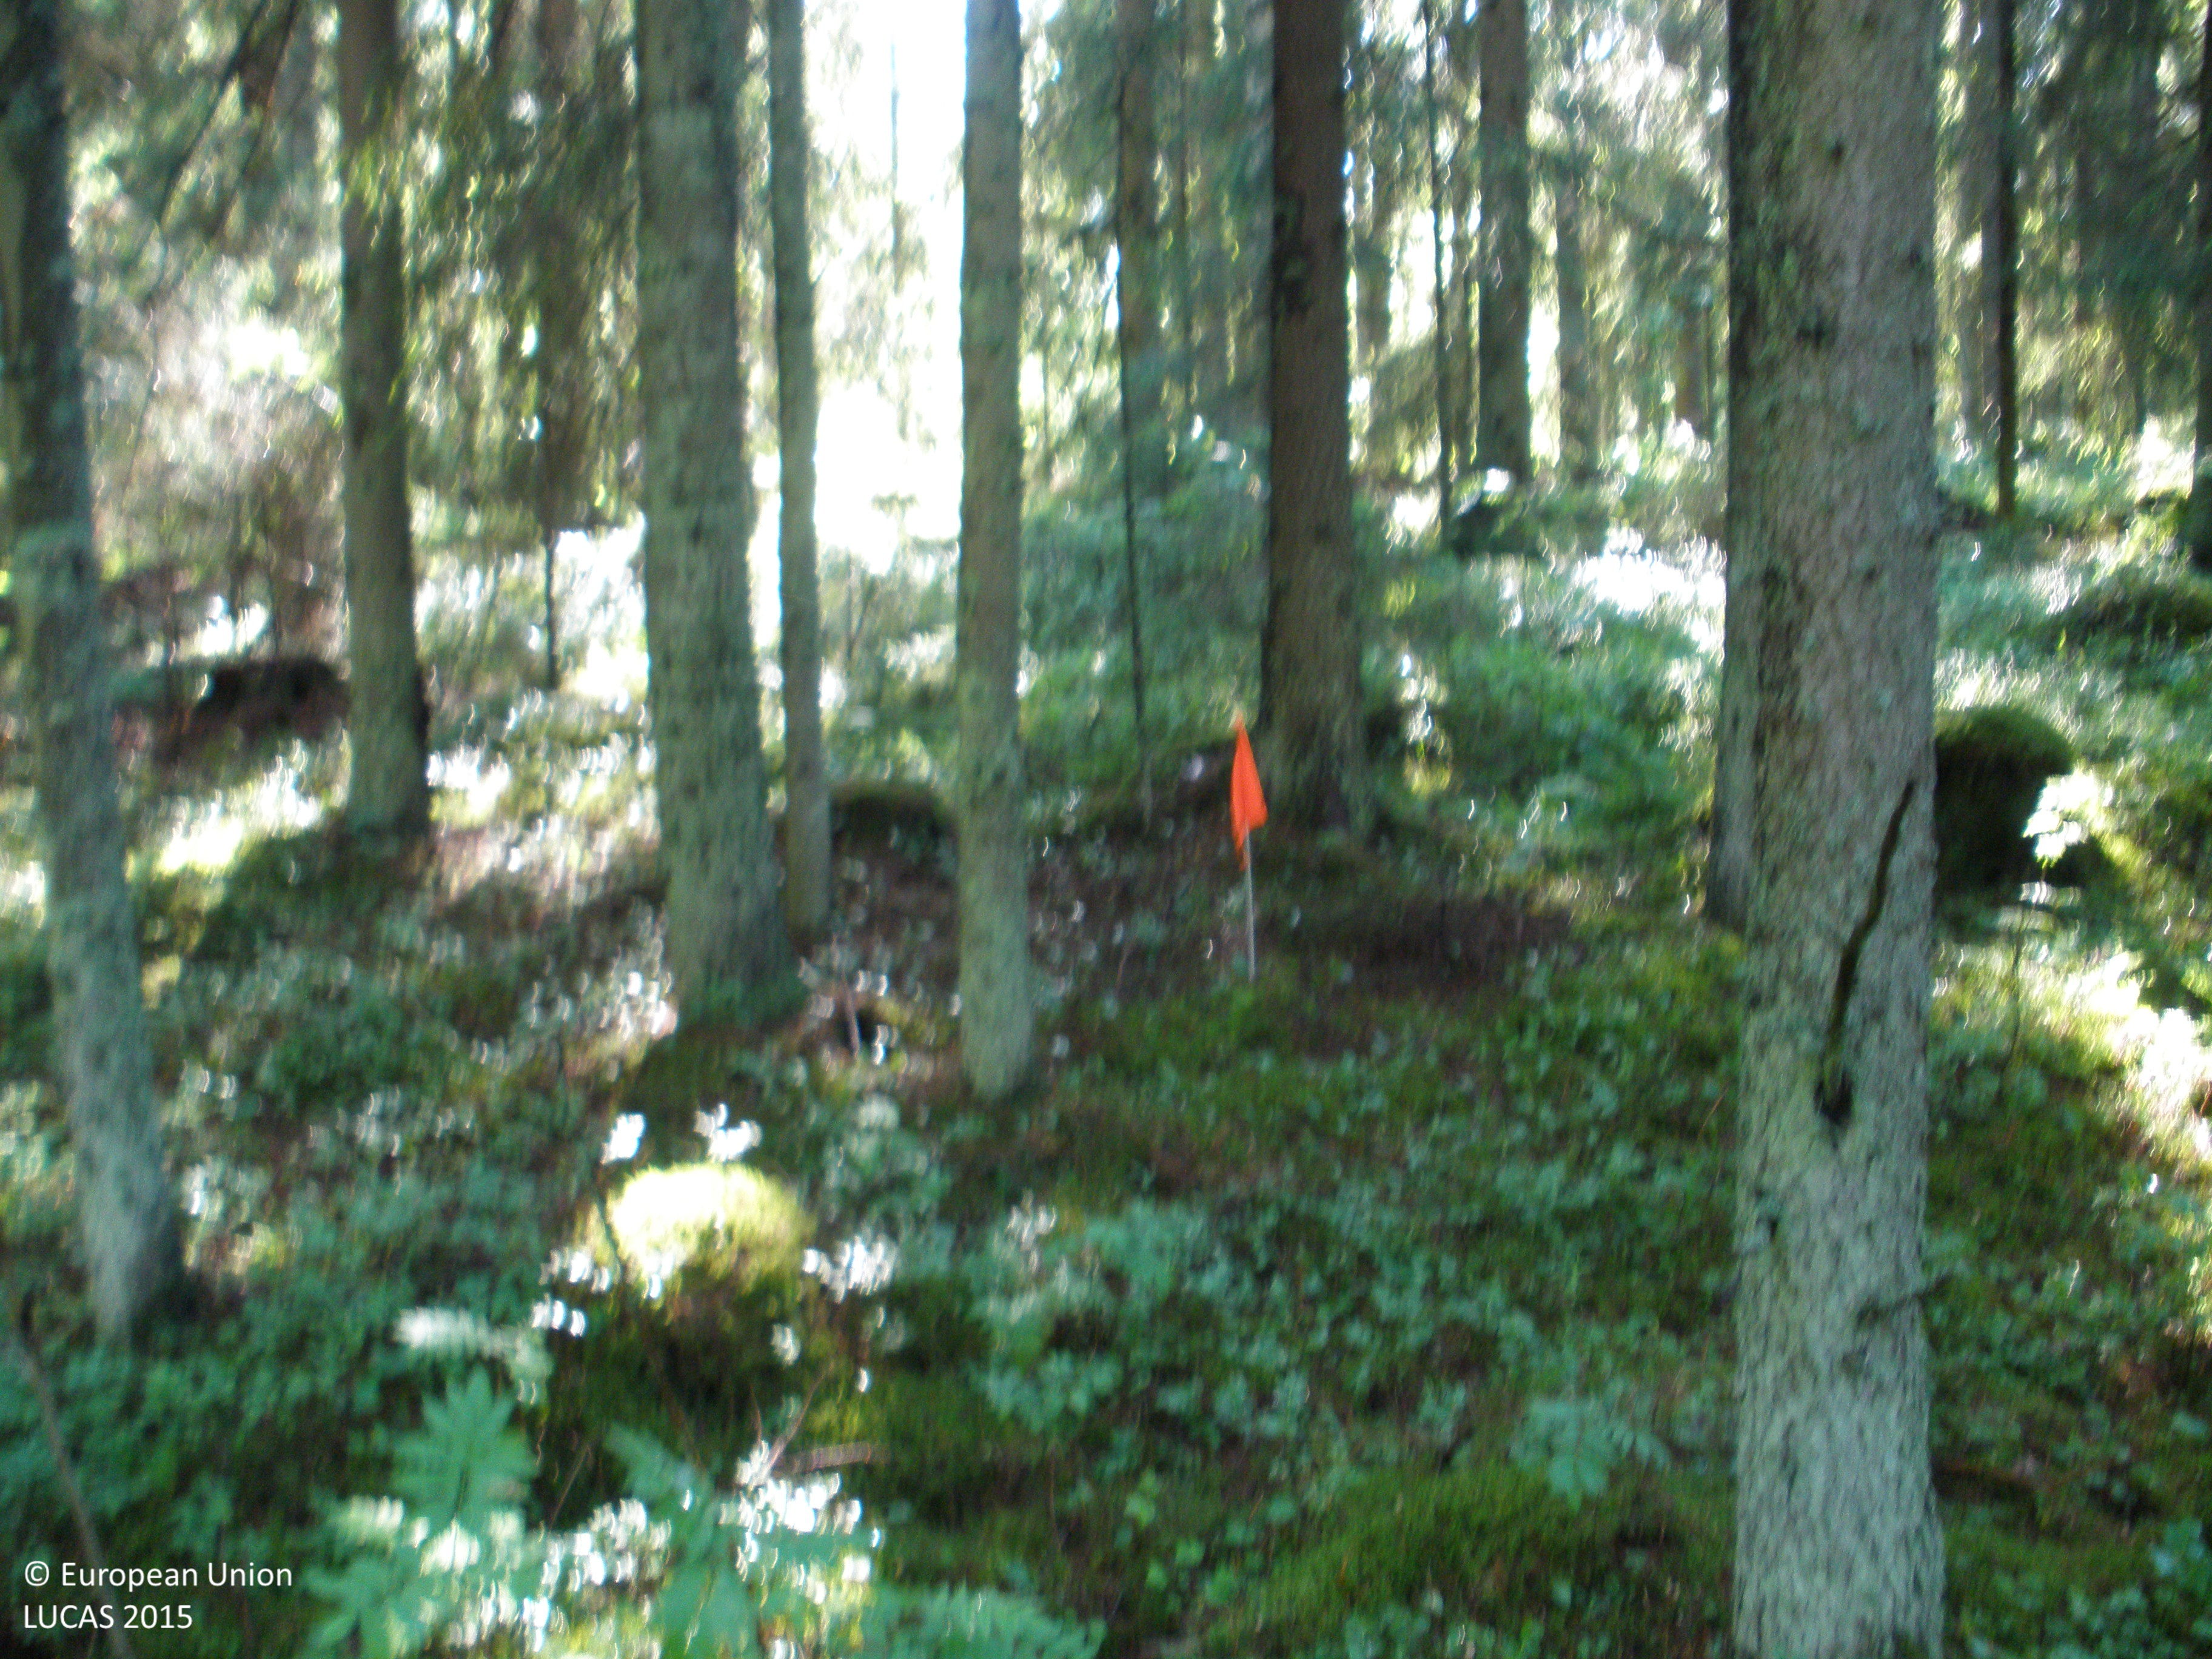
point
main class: Woodland
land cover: Spruce dominated coniferous woodland
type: boreal forest
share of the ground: > 75 %
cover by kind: coniferous forest trees 95 %, lichens and mosses 5 %
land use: Forestry
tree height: > 5 m
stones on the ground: < 10 %
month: June
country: FI
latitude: 60.9904
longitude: 23.5224
